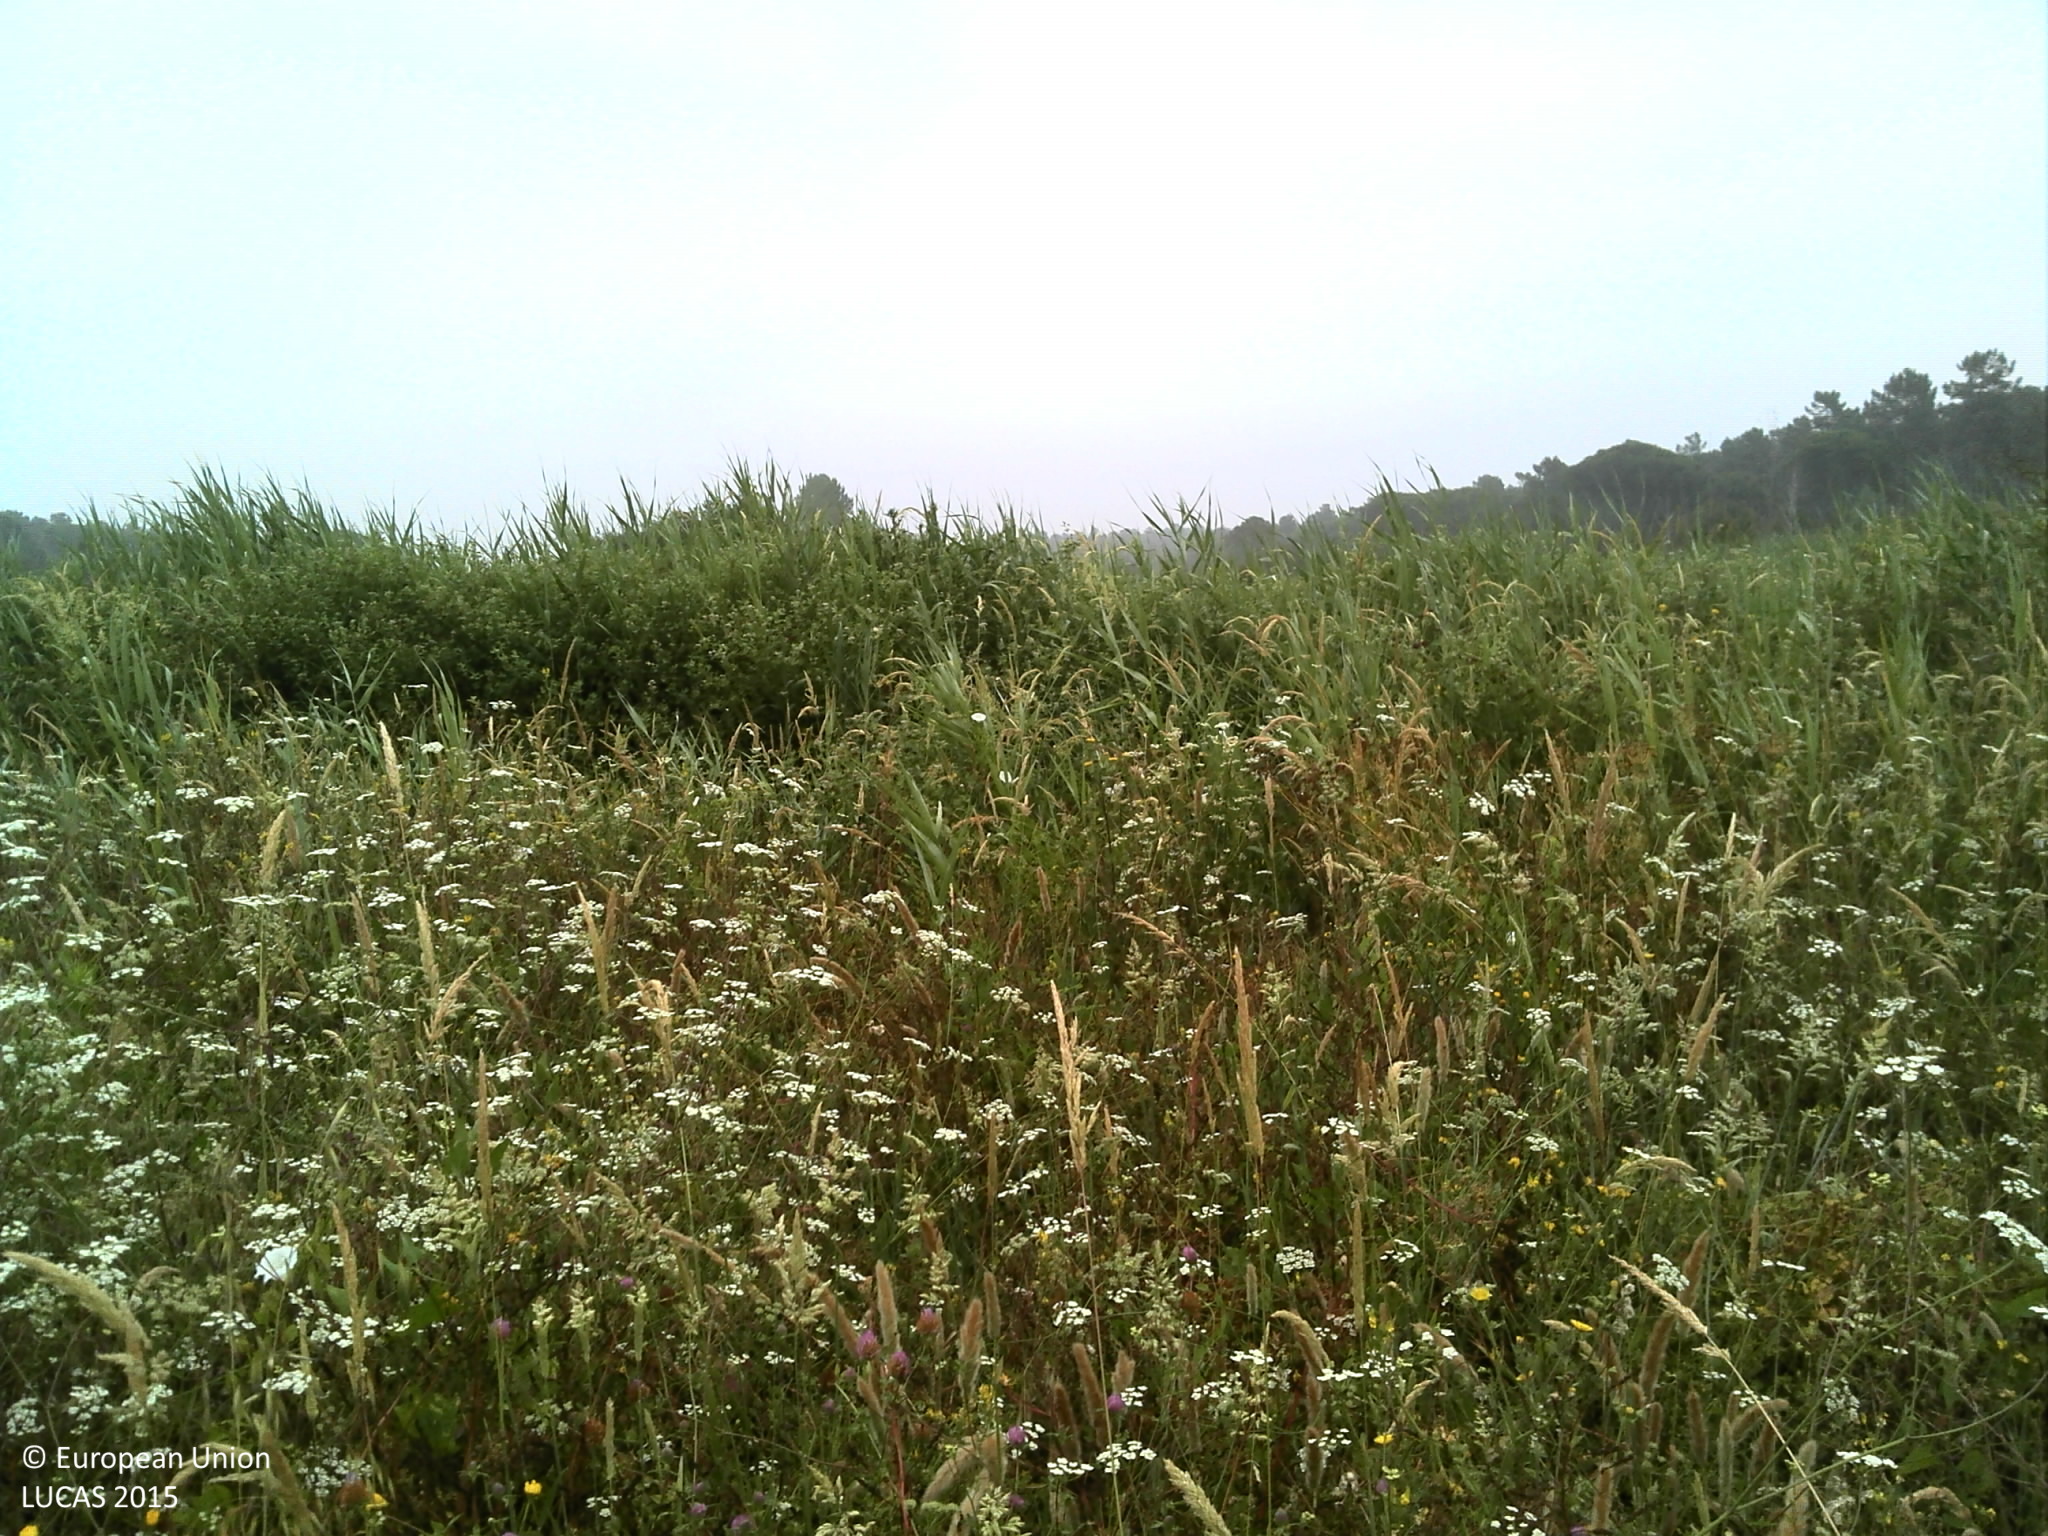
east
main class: Grassland
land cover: Spontaneously vegetated surfaces
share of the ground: > 75 %
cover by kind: herbaceous plants 95 %, unconsolidated bare surface 5 %
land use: Fallow land
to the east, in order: Spontaneously vegetated surfaces; Shrubland with sparse tree cover
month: June
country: PT
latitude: 38.5327
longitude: -9.1252
